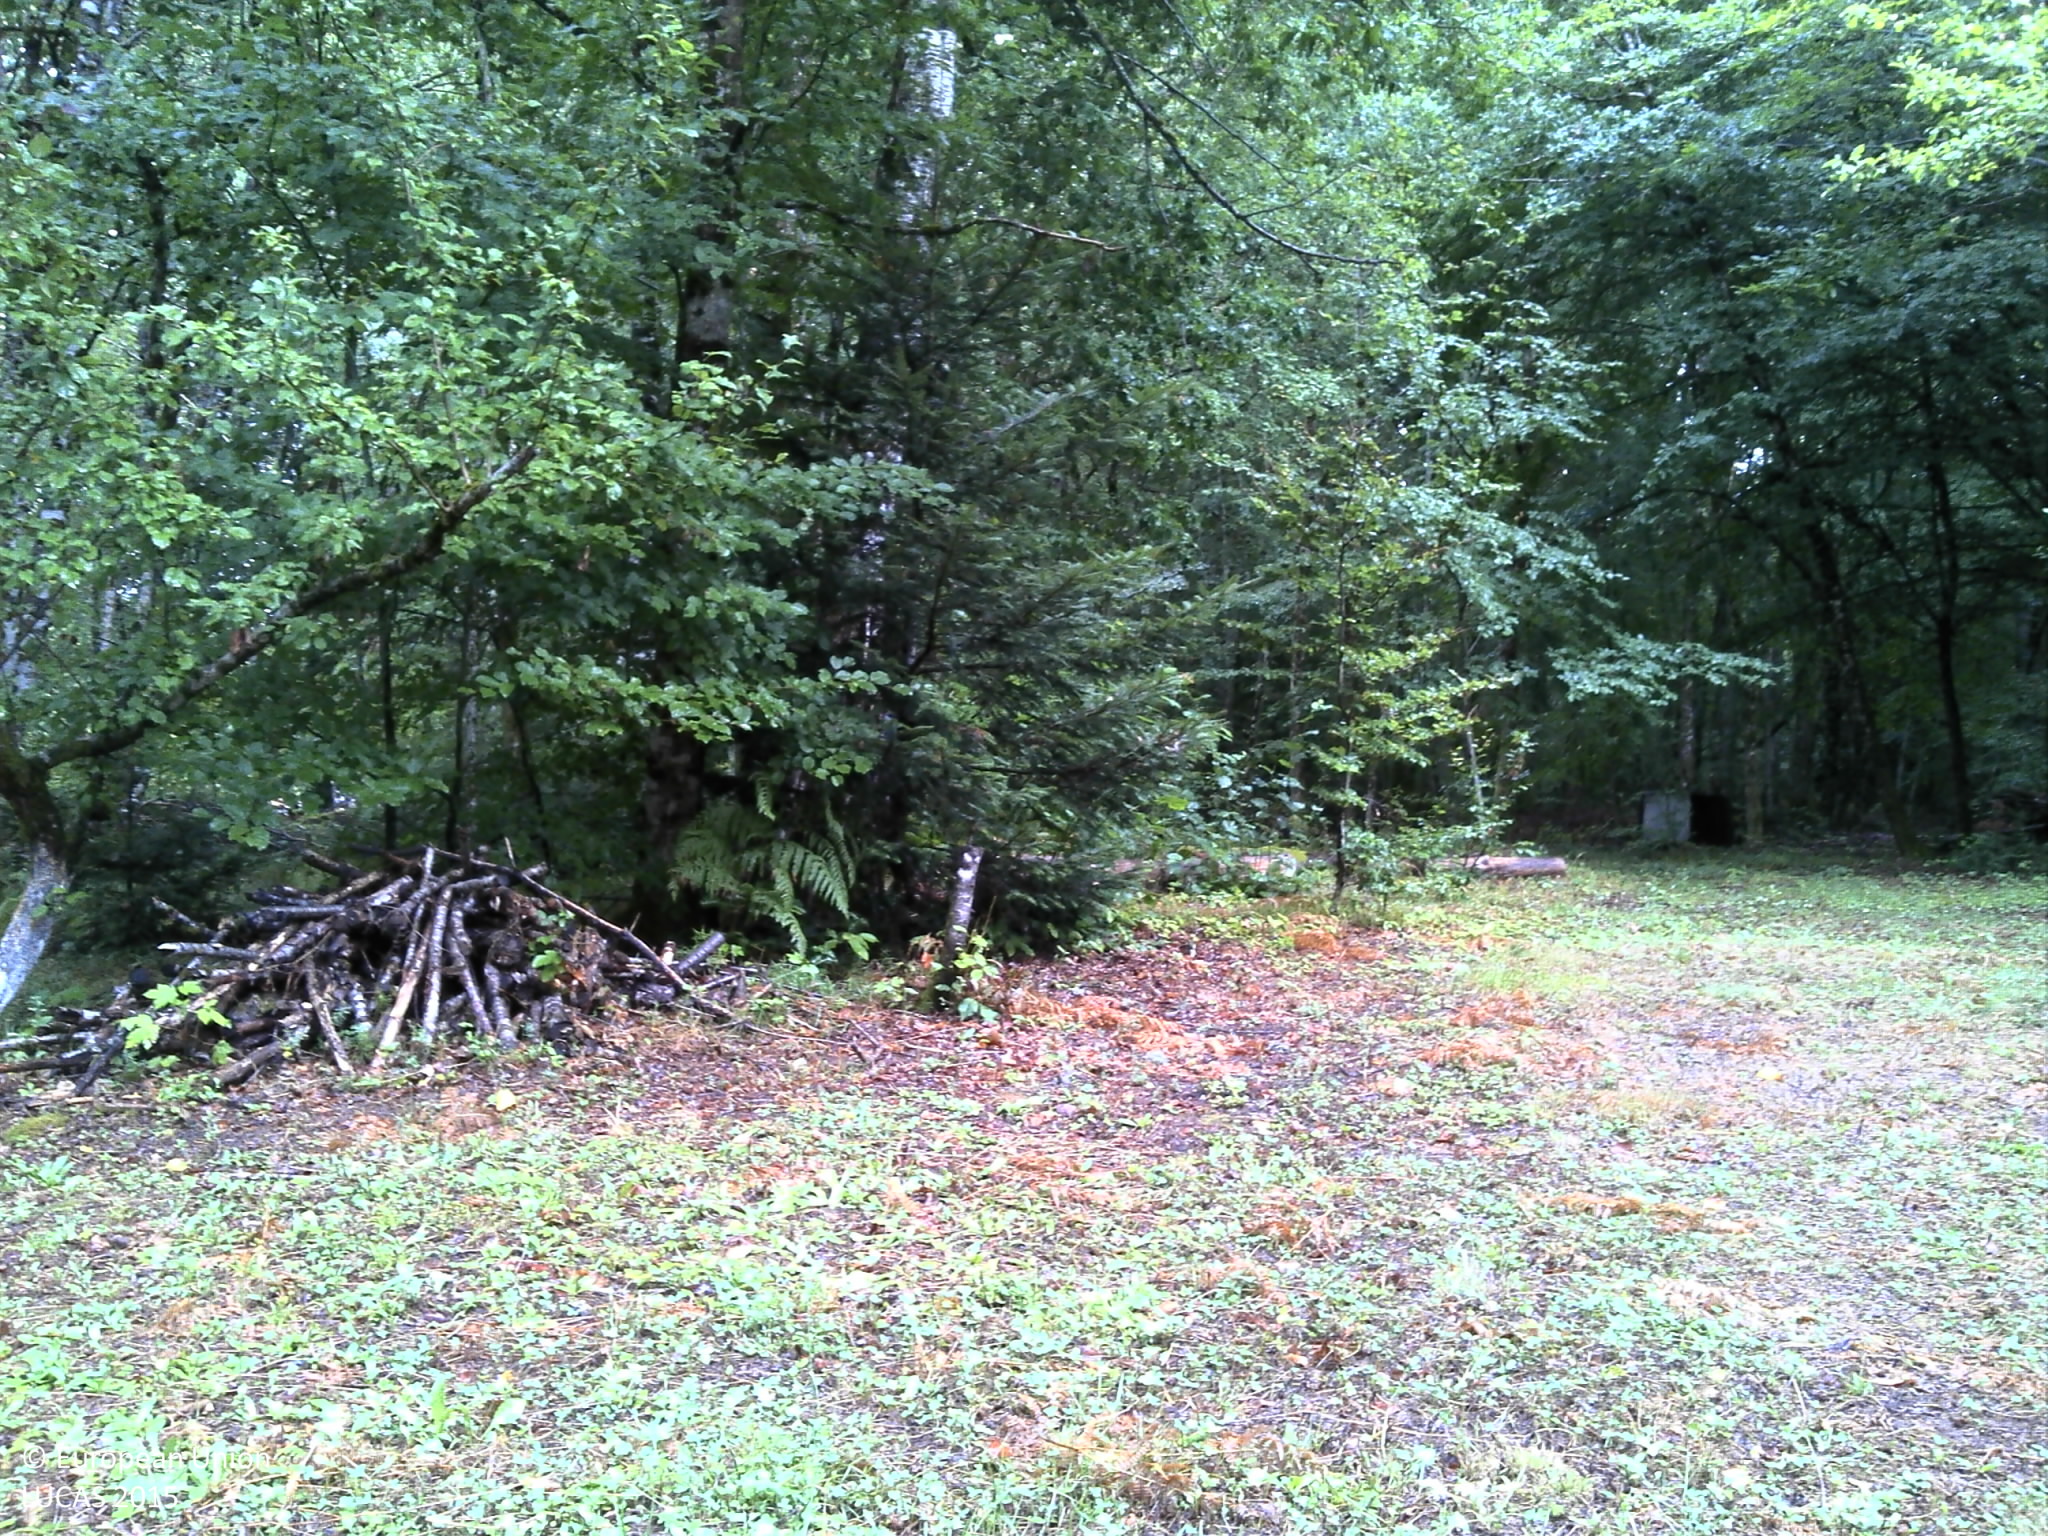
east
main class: Woodland
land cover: Broadleaved woodland
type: acidophilous oak and oak-birch forest
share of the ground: > 75 %
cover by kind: broadleaved forest trees 70 %, unconsolidated bare surface 20 %, herbaceous plants 5 %, lichens and mosses 5 %
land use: Forestry
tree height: > 5 m
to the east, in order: Broadleaved woodland; Fences; Grassland with sparse tree/shrub cover; Artificial constructions in urban areas; Broadleaved woodland; Fences; Grass margins; Paved roads, cycling and walking lanes; Ditches and canals; Fences; Spruce dominated mixed woodland; Tracks; Spruce dominated mixed woodland
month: August
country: FR
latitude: 45.3874
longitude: 2.3221
